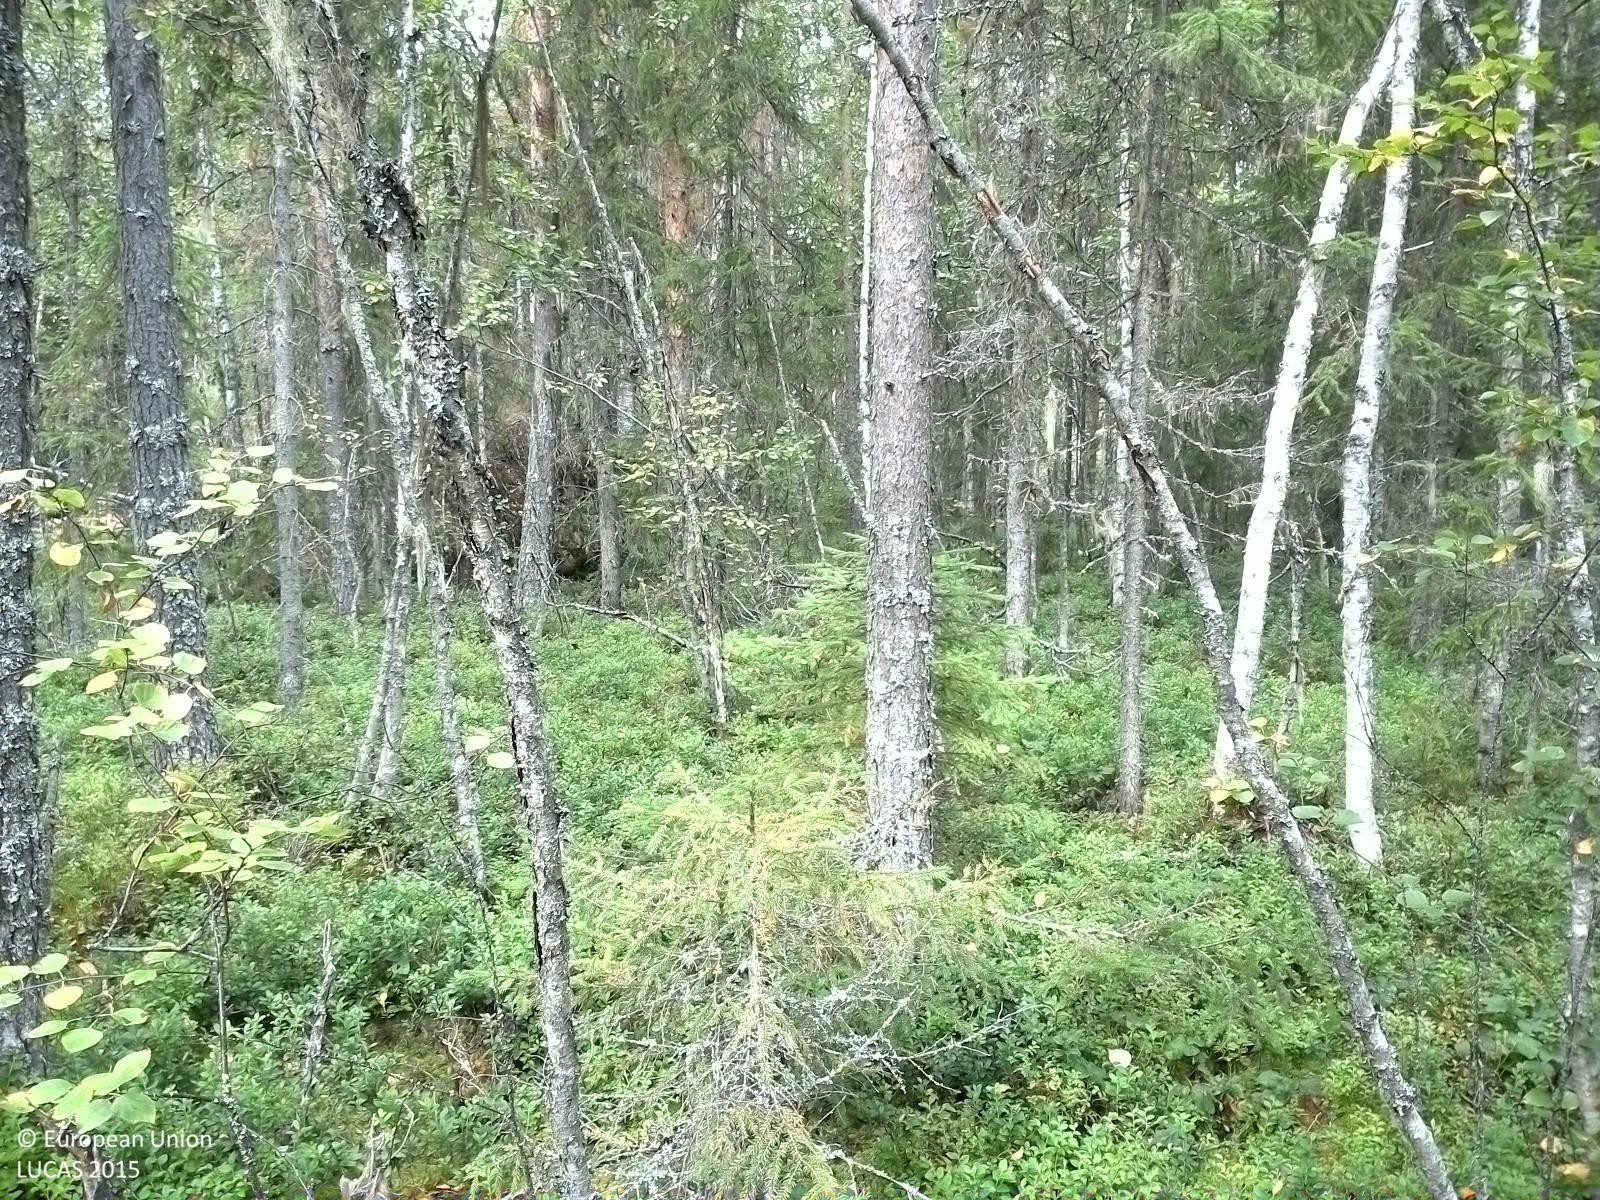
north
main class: Woodland
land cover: Spruce dominated mixed woodland
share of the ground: 50 - 75 %
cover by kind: shrubs 45 %, coniferous forest trees 40 %, broadleaved forest trees 15 %
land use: Forestry
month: August
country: SE
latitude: 62.4094
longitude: 16.2696
